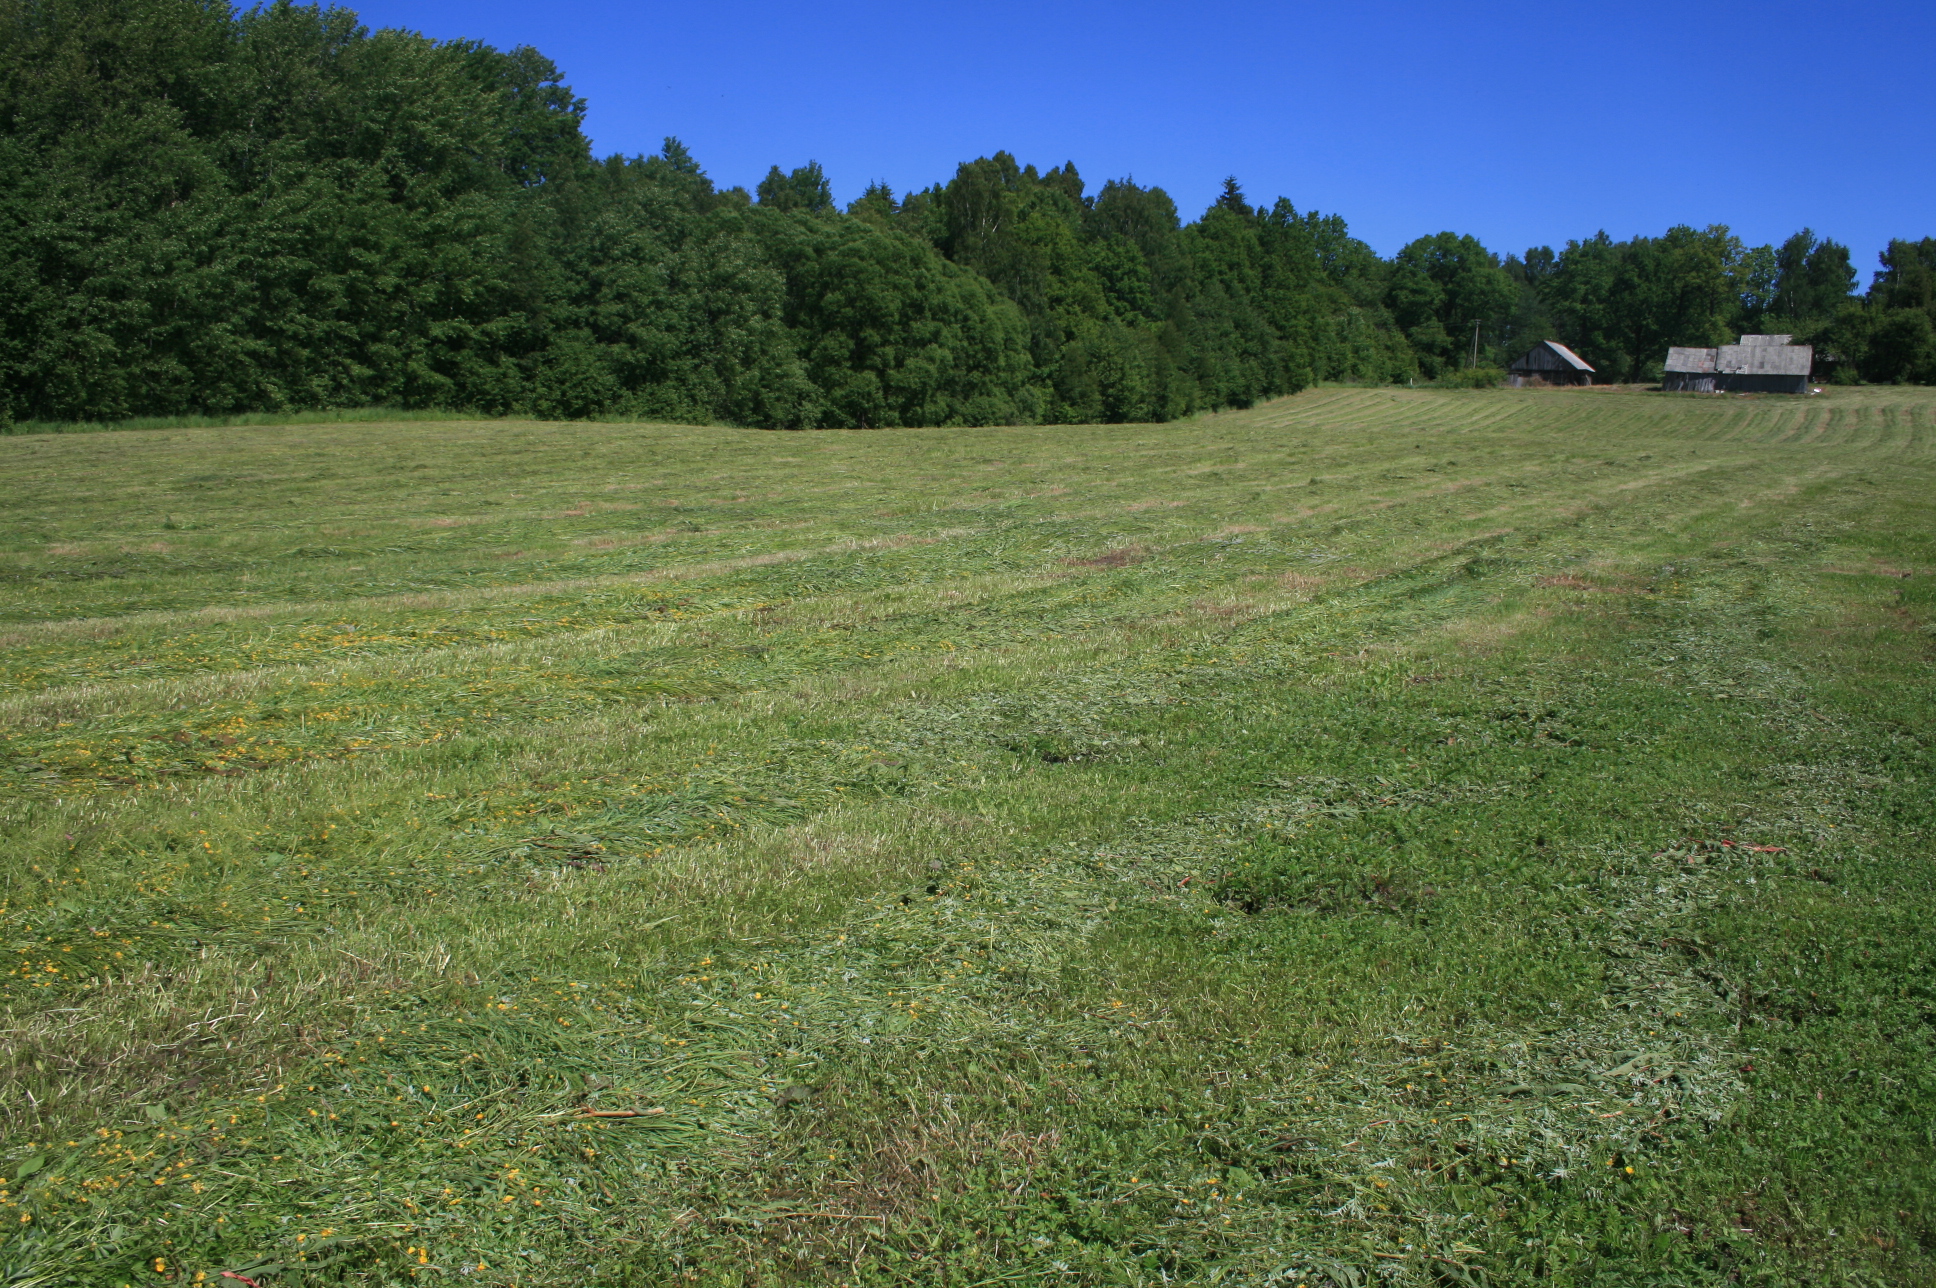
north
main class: Grassland
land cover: Grassland without tree/shrub cover
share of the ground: > 75 %
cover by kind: herbaceous plants 100 %
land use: Agriculture (excluding fallow land and kitchen gardens)
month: June
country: LT
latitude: 55.5769
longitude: 22.0932
